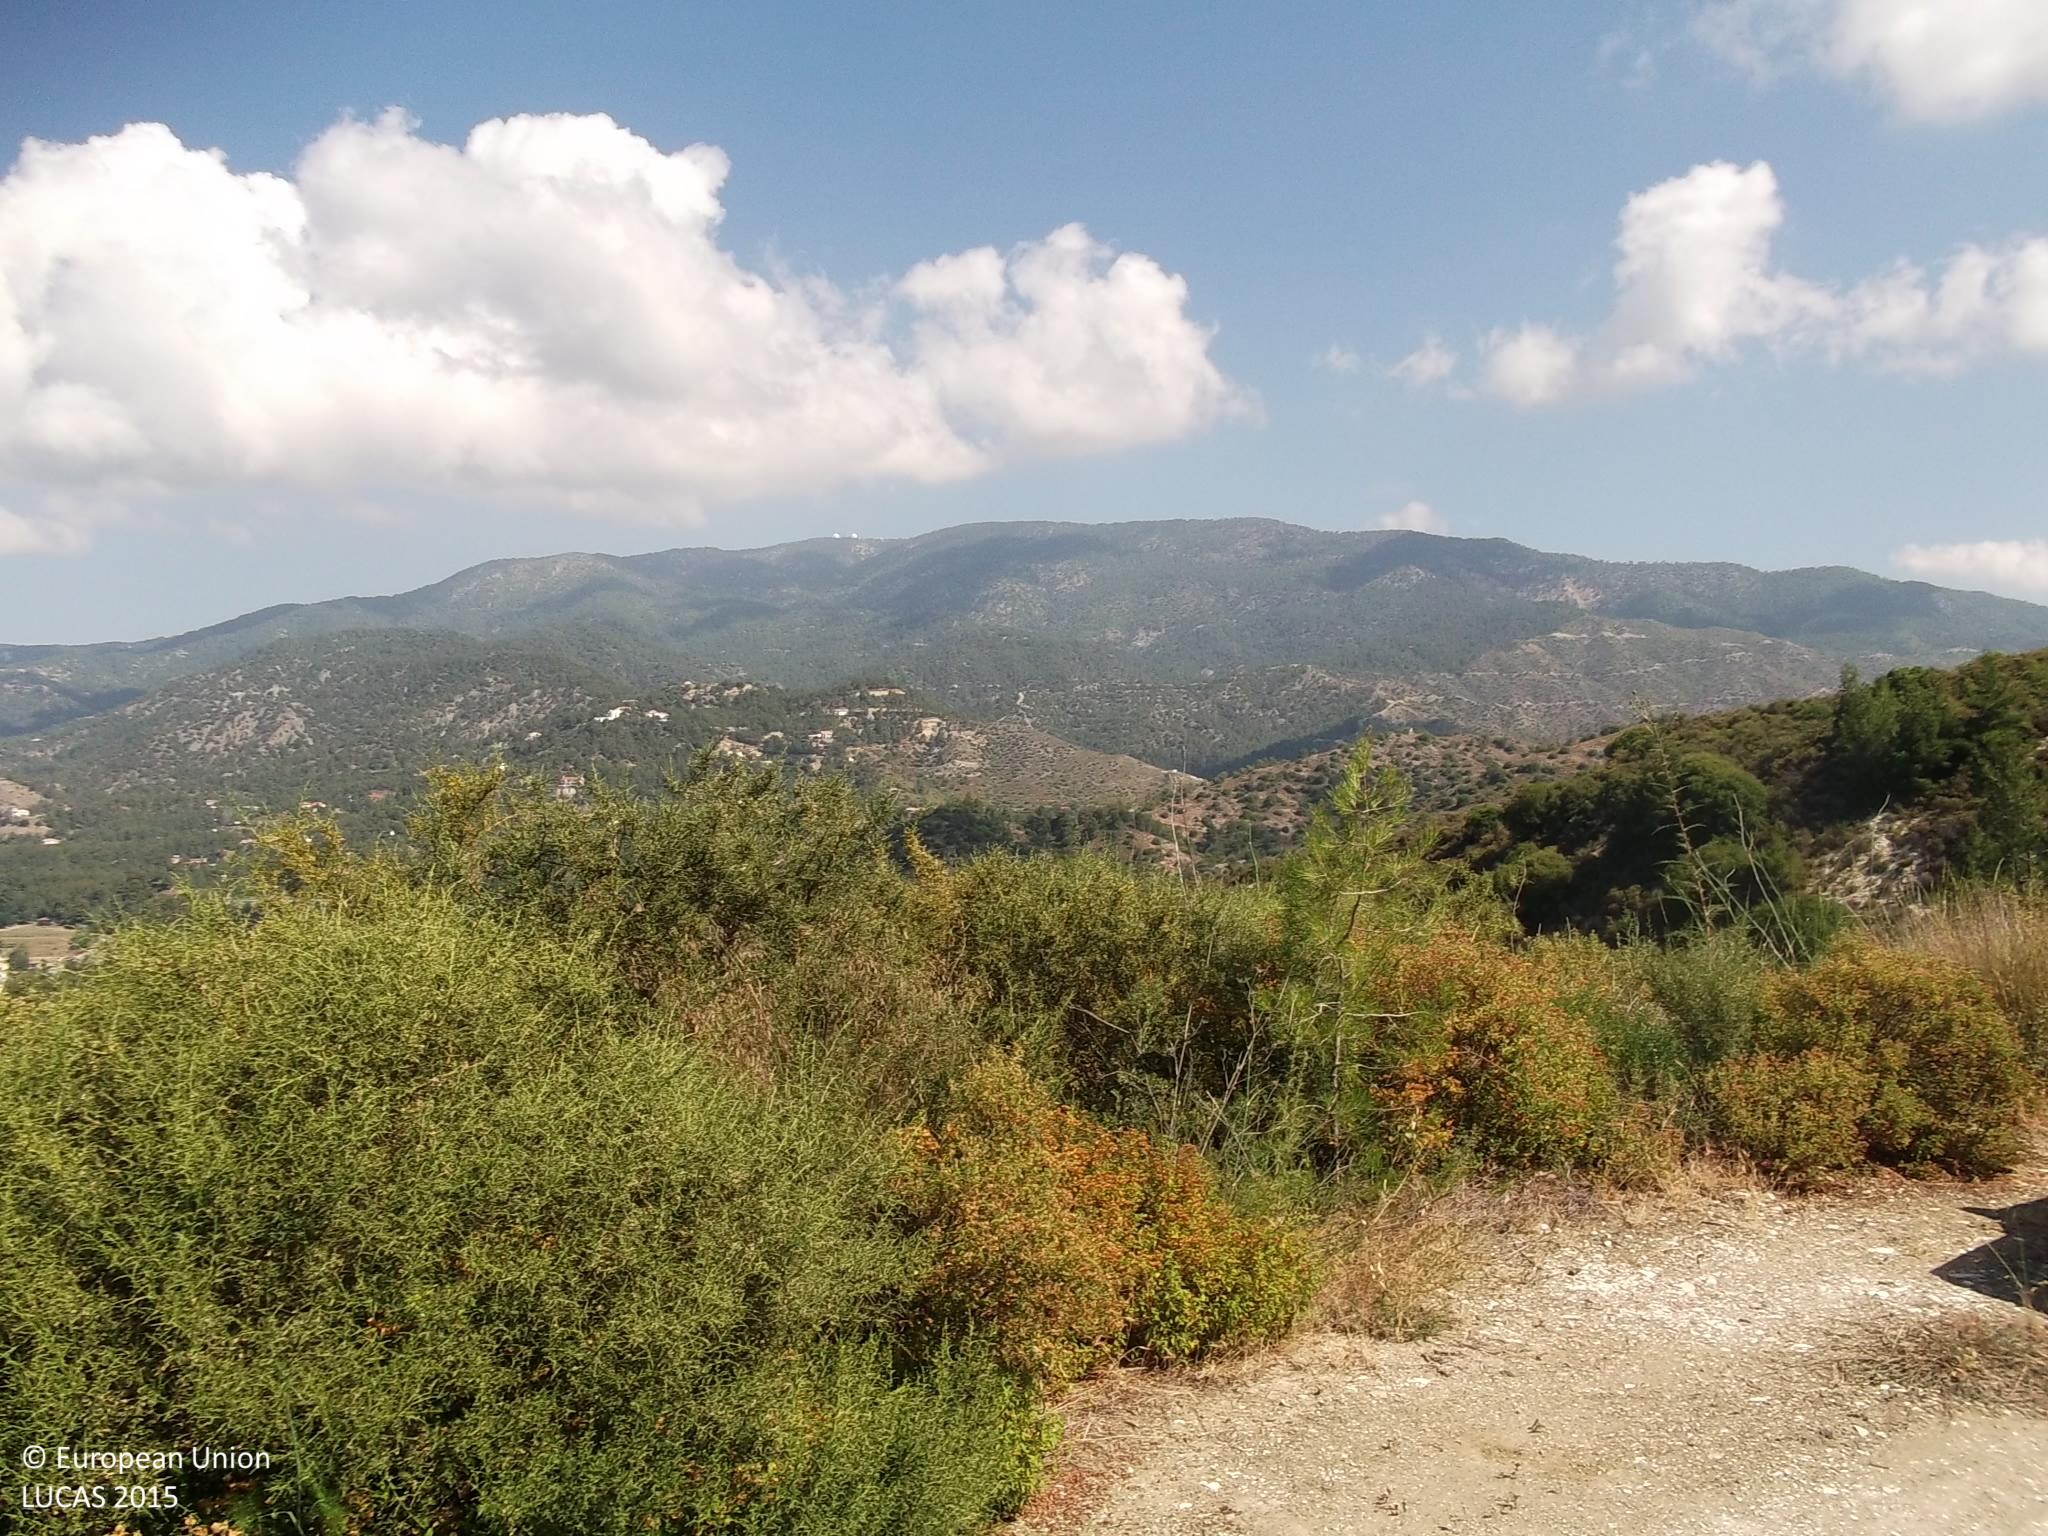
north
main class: Woodland
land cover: Pine dominated coniferous woodland
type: coniferous forest of the mediterranean region
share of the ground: 25 - 50 %
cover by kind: coniferous forest trees 40 %, shrubs 40 %, unconsolidated bare surface 20 %
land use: Forestry
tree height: > 5 m
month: June
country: CY
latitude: 34.8505
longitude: 32.9257
